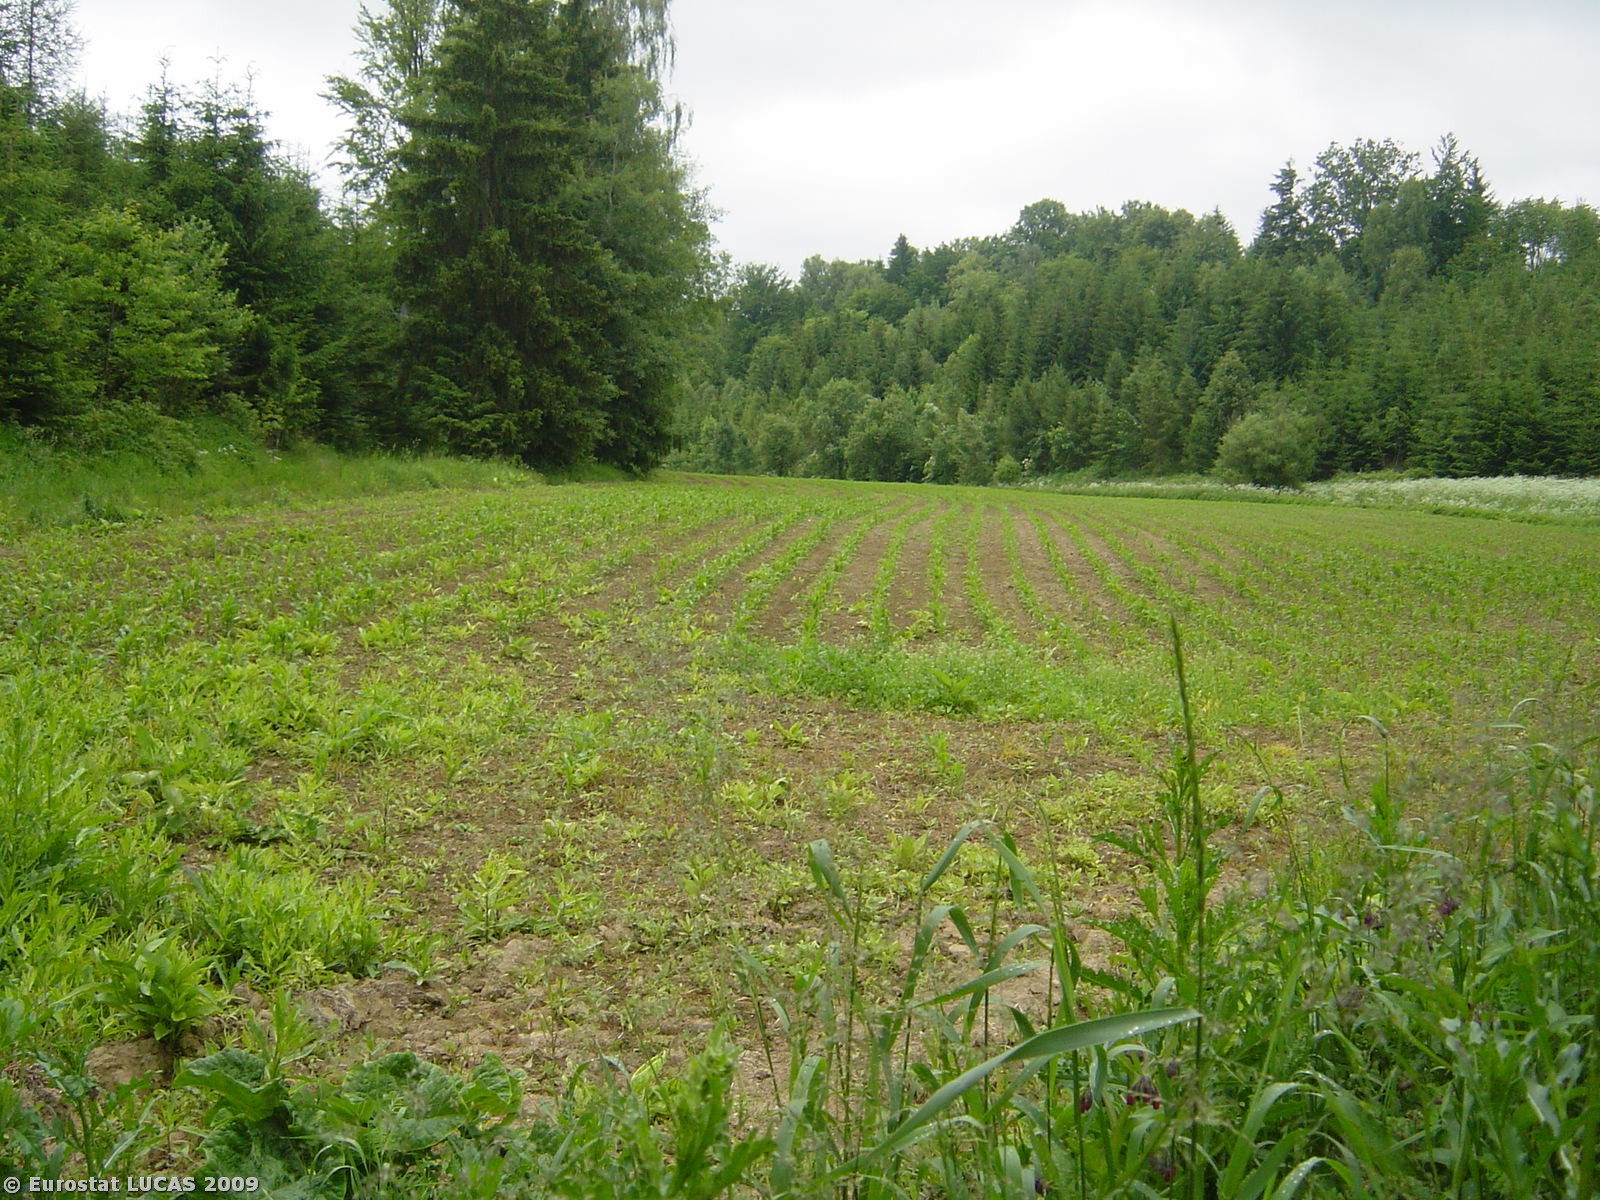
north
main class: Grassland
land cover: Grassland without tree/shrub cover
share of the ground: > 75 %
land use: Unused
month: June
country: CZ
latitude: 49.7273
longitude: 16.5136
